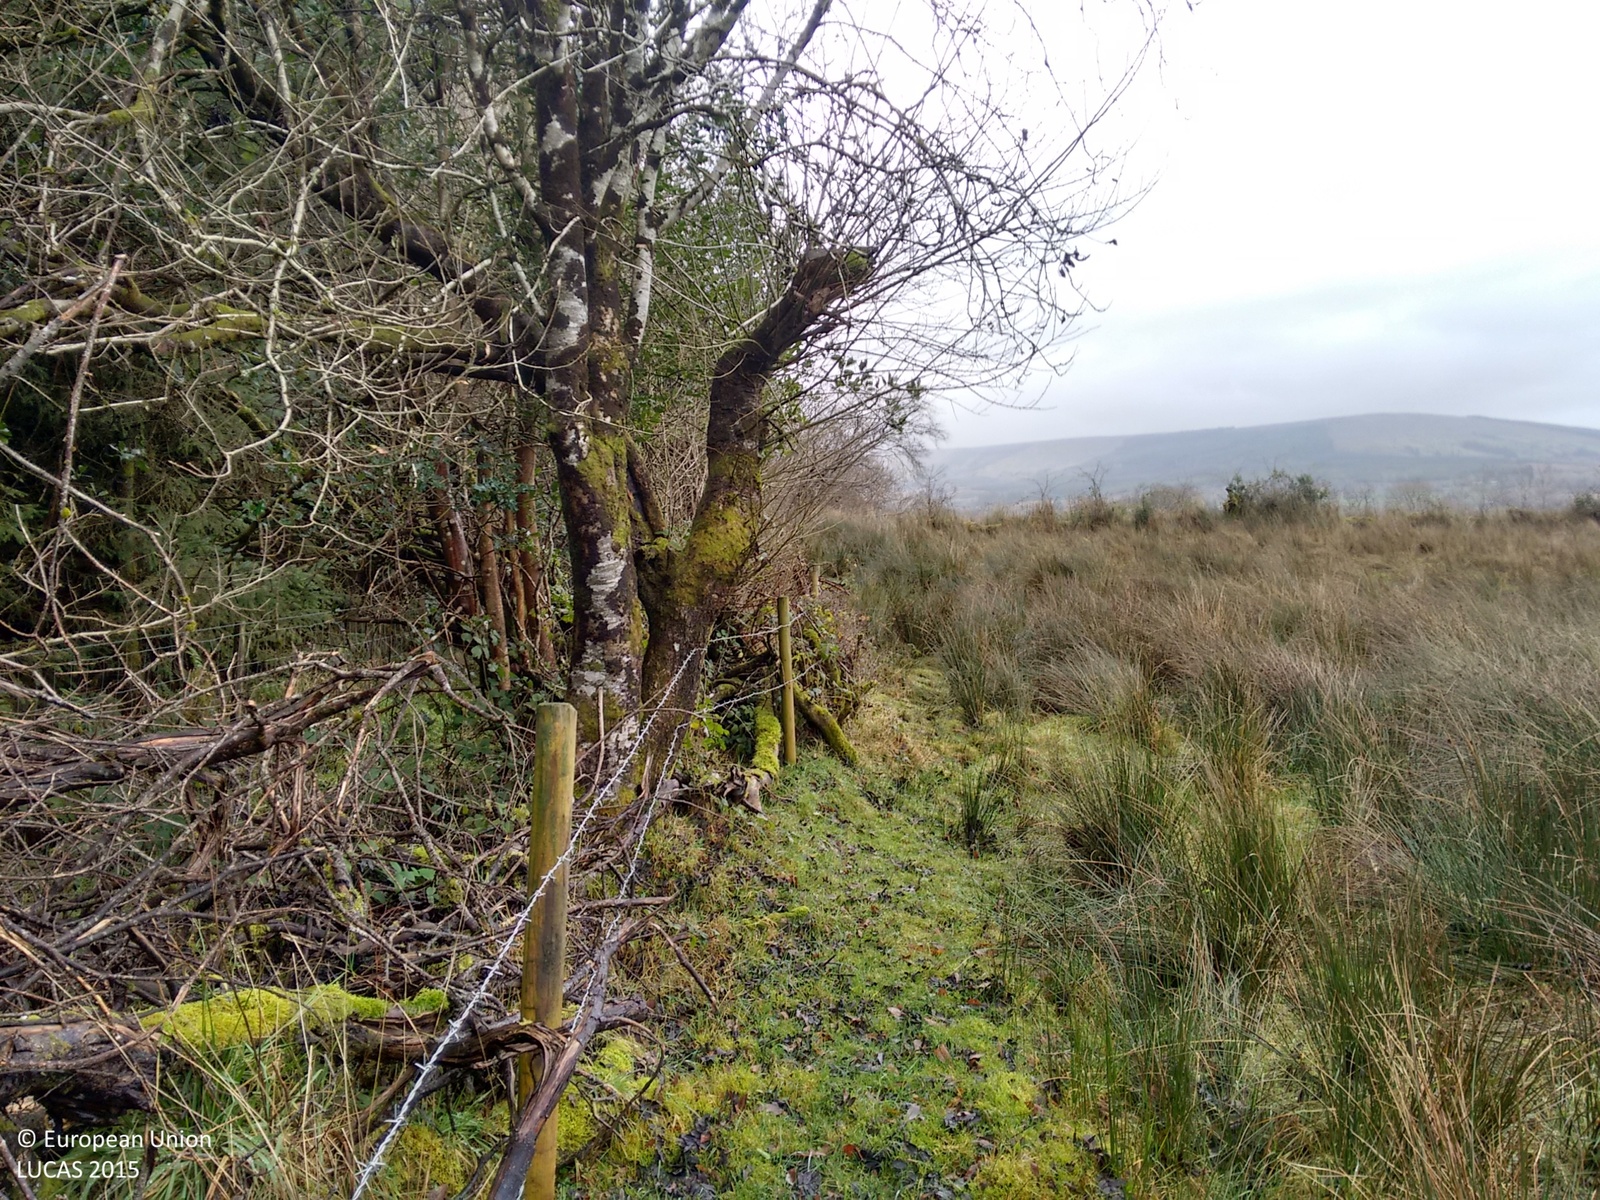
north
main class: Grassland
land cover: Grassland without tree/shrub cover
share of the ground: > 75 %
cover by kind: herbaceous plants 100 %
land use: Agriculture (excluding fallow land and kitchen gardens)
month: December
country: IE
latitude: 54.2911
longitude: -8.1060
